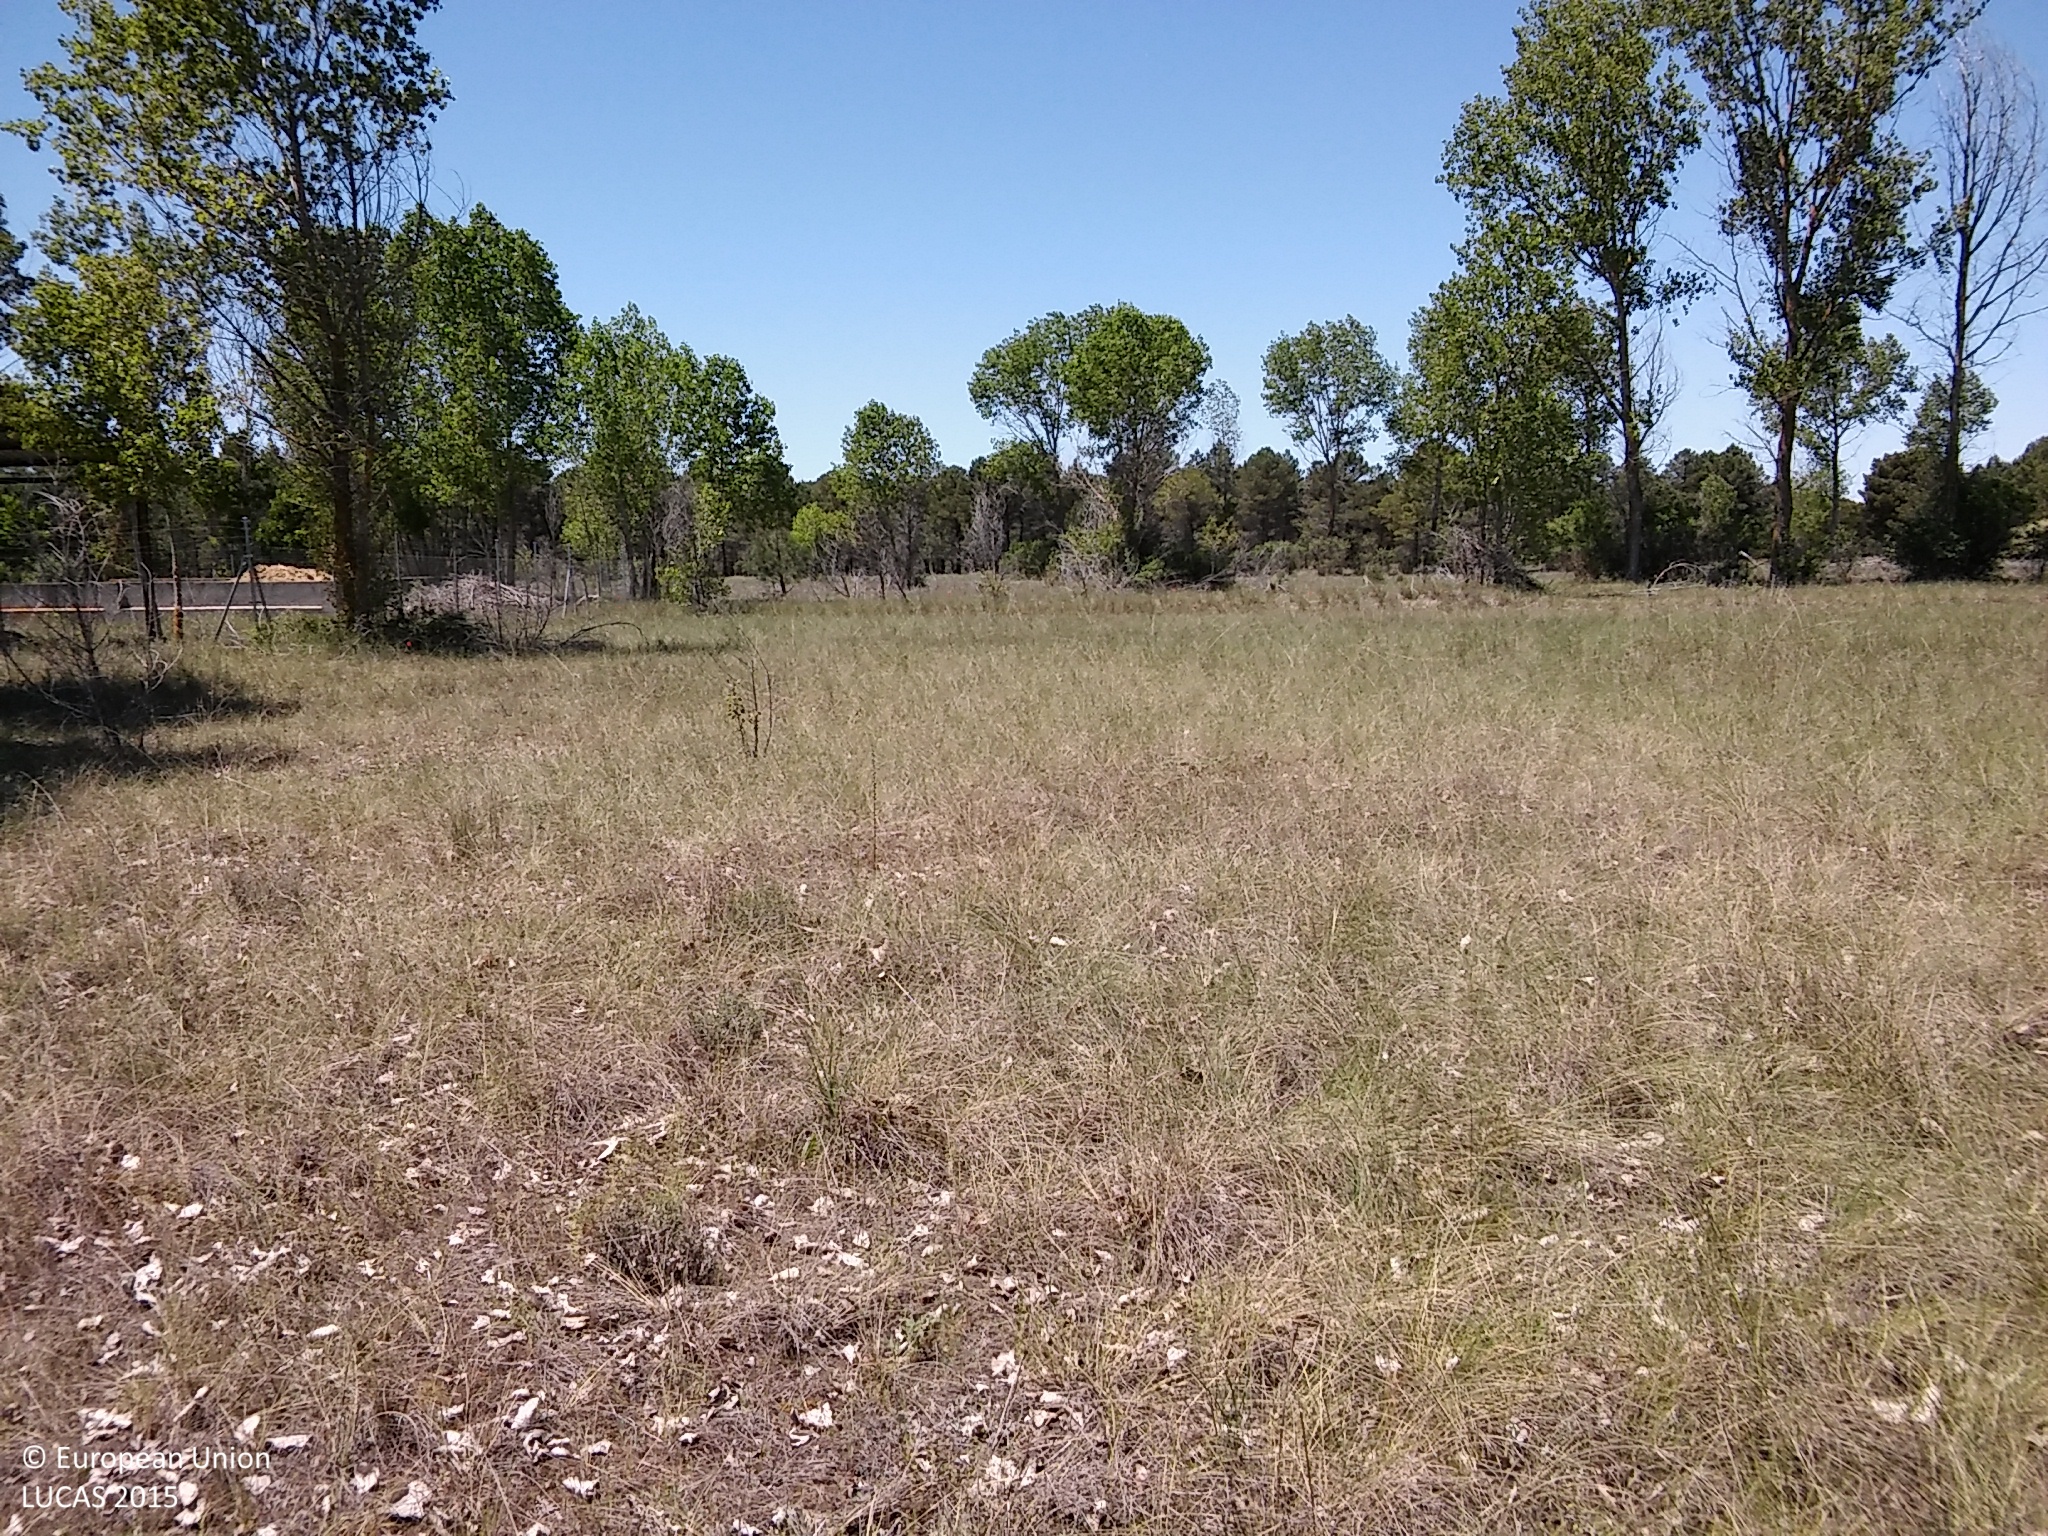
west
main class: Grassland
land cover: Grassland without tree/shrub cover
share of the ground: > 75 %
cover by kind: herbaceous plants 95 %, shrubs 5 %
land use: Semi-natural and natural areas not in use
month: May
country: ES
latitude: 41.2269
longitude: -4.0702
